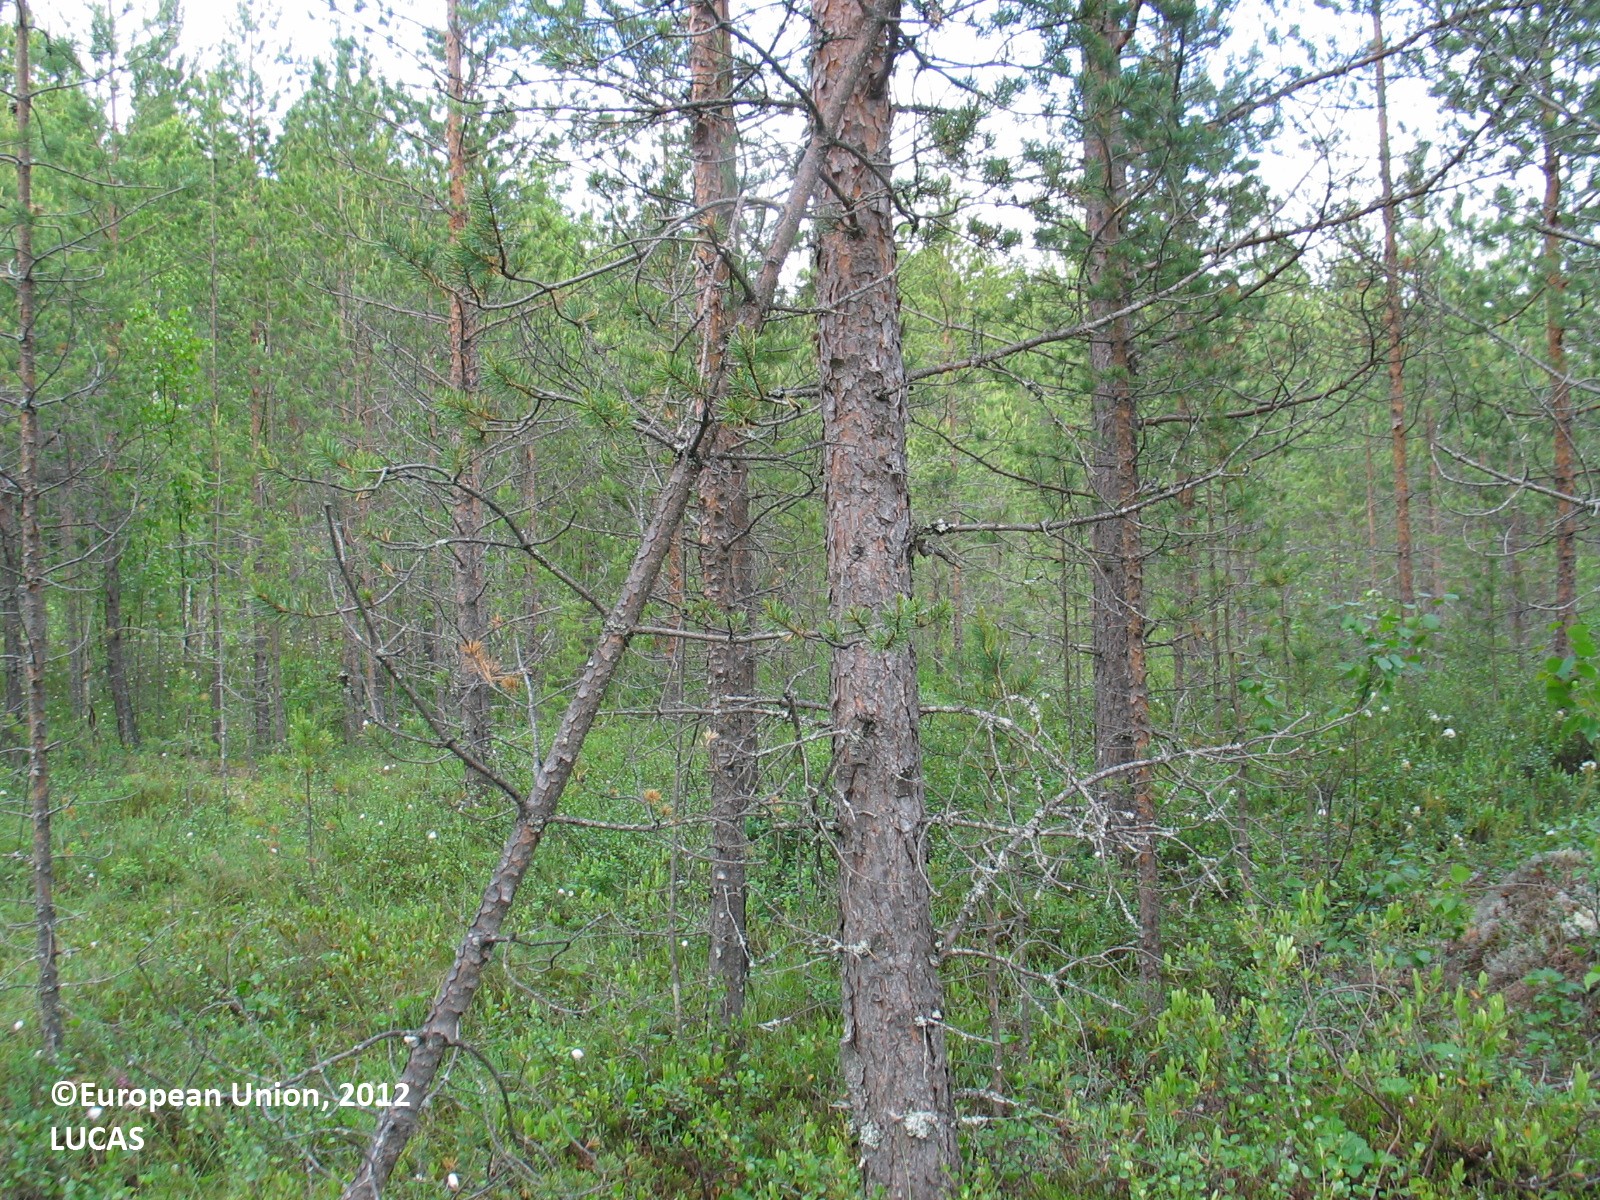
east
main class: Woodland
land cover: Pine dominated coniferous woodland
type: mire and swamp forests
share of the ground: 25 - 50 %
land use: Forestry
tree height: > 5 m
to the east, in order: Pine dominated coniferous woodland; Ditches and canals; Pine dominated coniferous woodland; Ditches and canals; Groves; Paved roads, cycling and walking lanes; Grass margins; Ditches and canals; Pine dominated coniferous woodland; Tracks; Pine dominated mixed woodland; Pine dominated coniferous woodland; Tracks
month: June
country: FI
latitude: 64.8725
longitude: 26.2062
